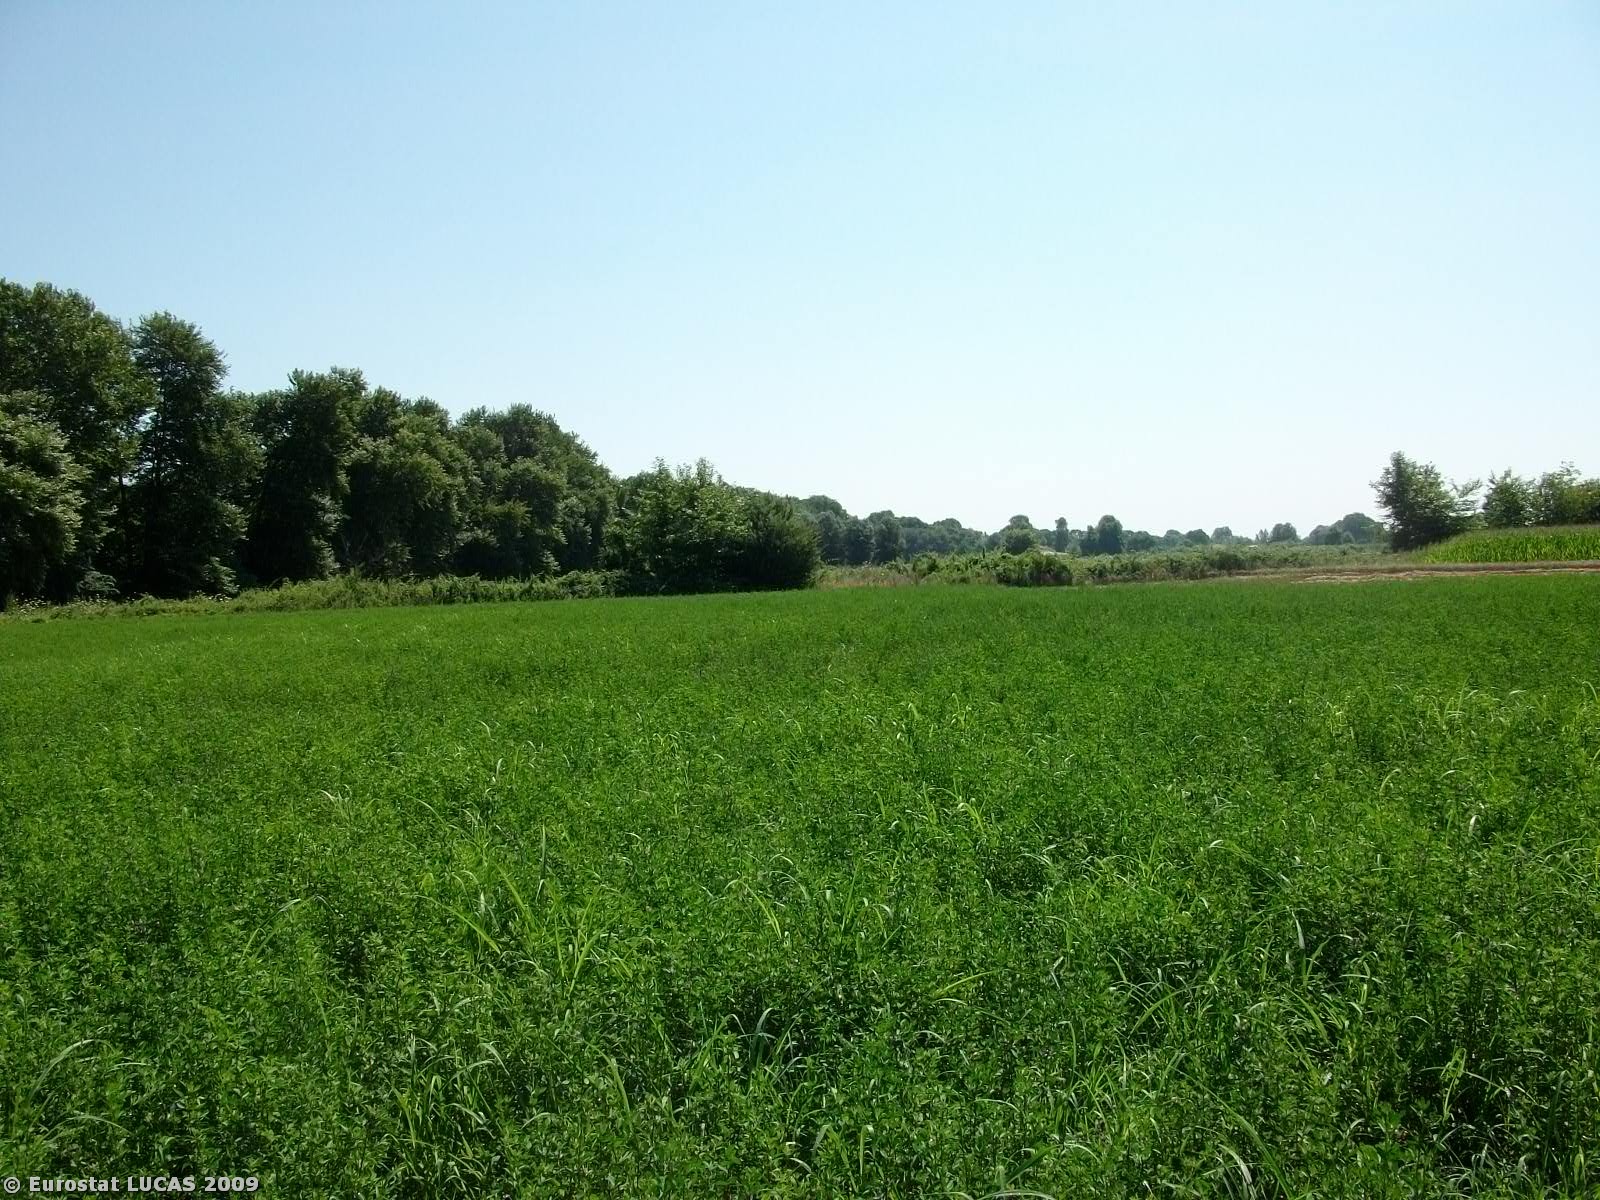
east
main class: Cropland
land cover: Clovers
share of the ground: > 75 %
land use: Agriculture (excluding fallow land and kitchen gardens)
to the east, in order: Clovers; Abandoned hedges; Tracks; Durum wheat
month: July
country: GR
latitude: 39.5285
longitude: 21.6976
